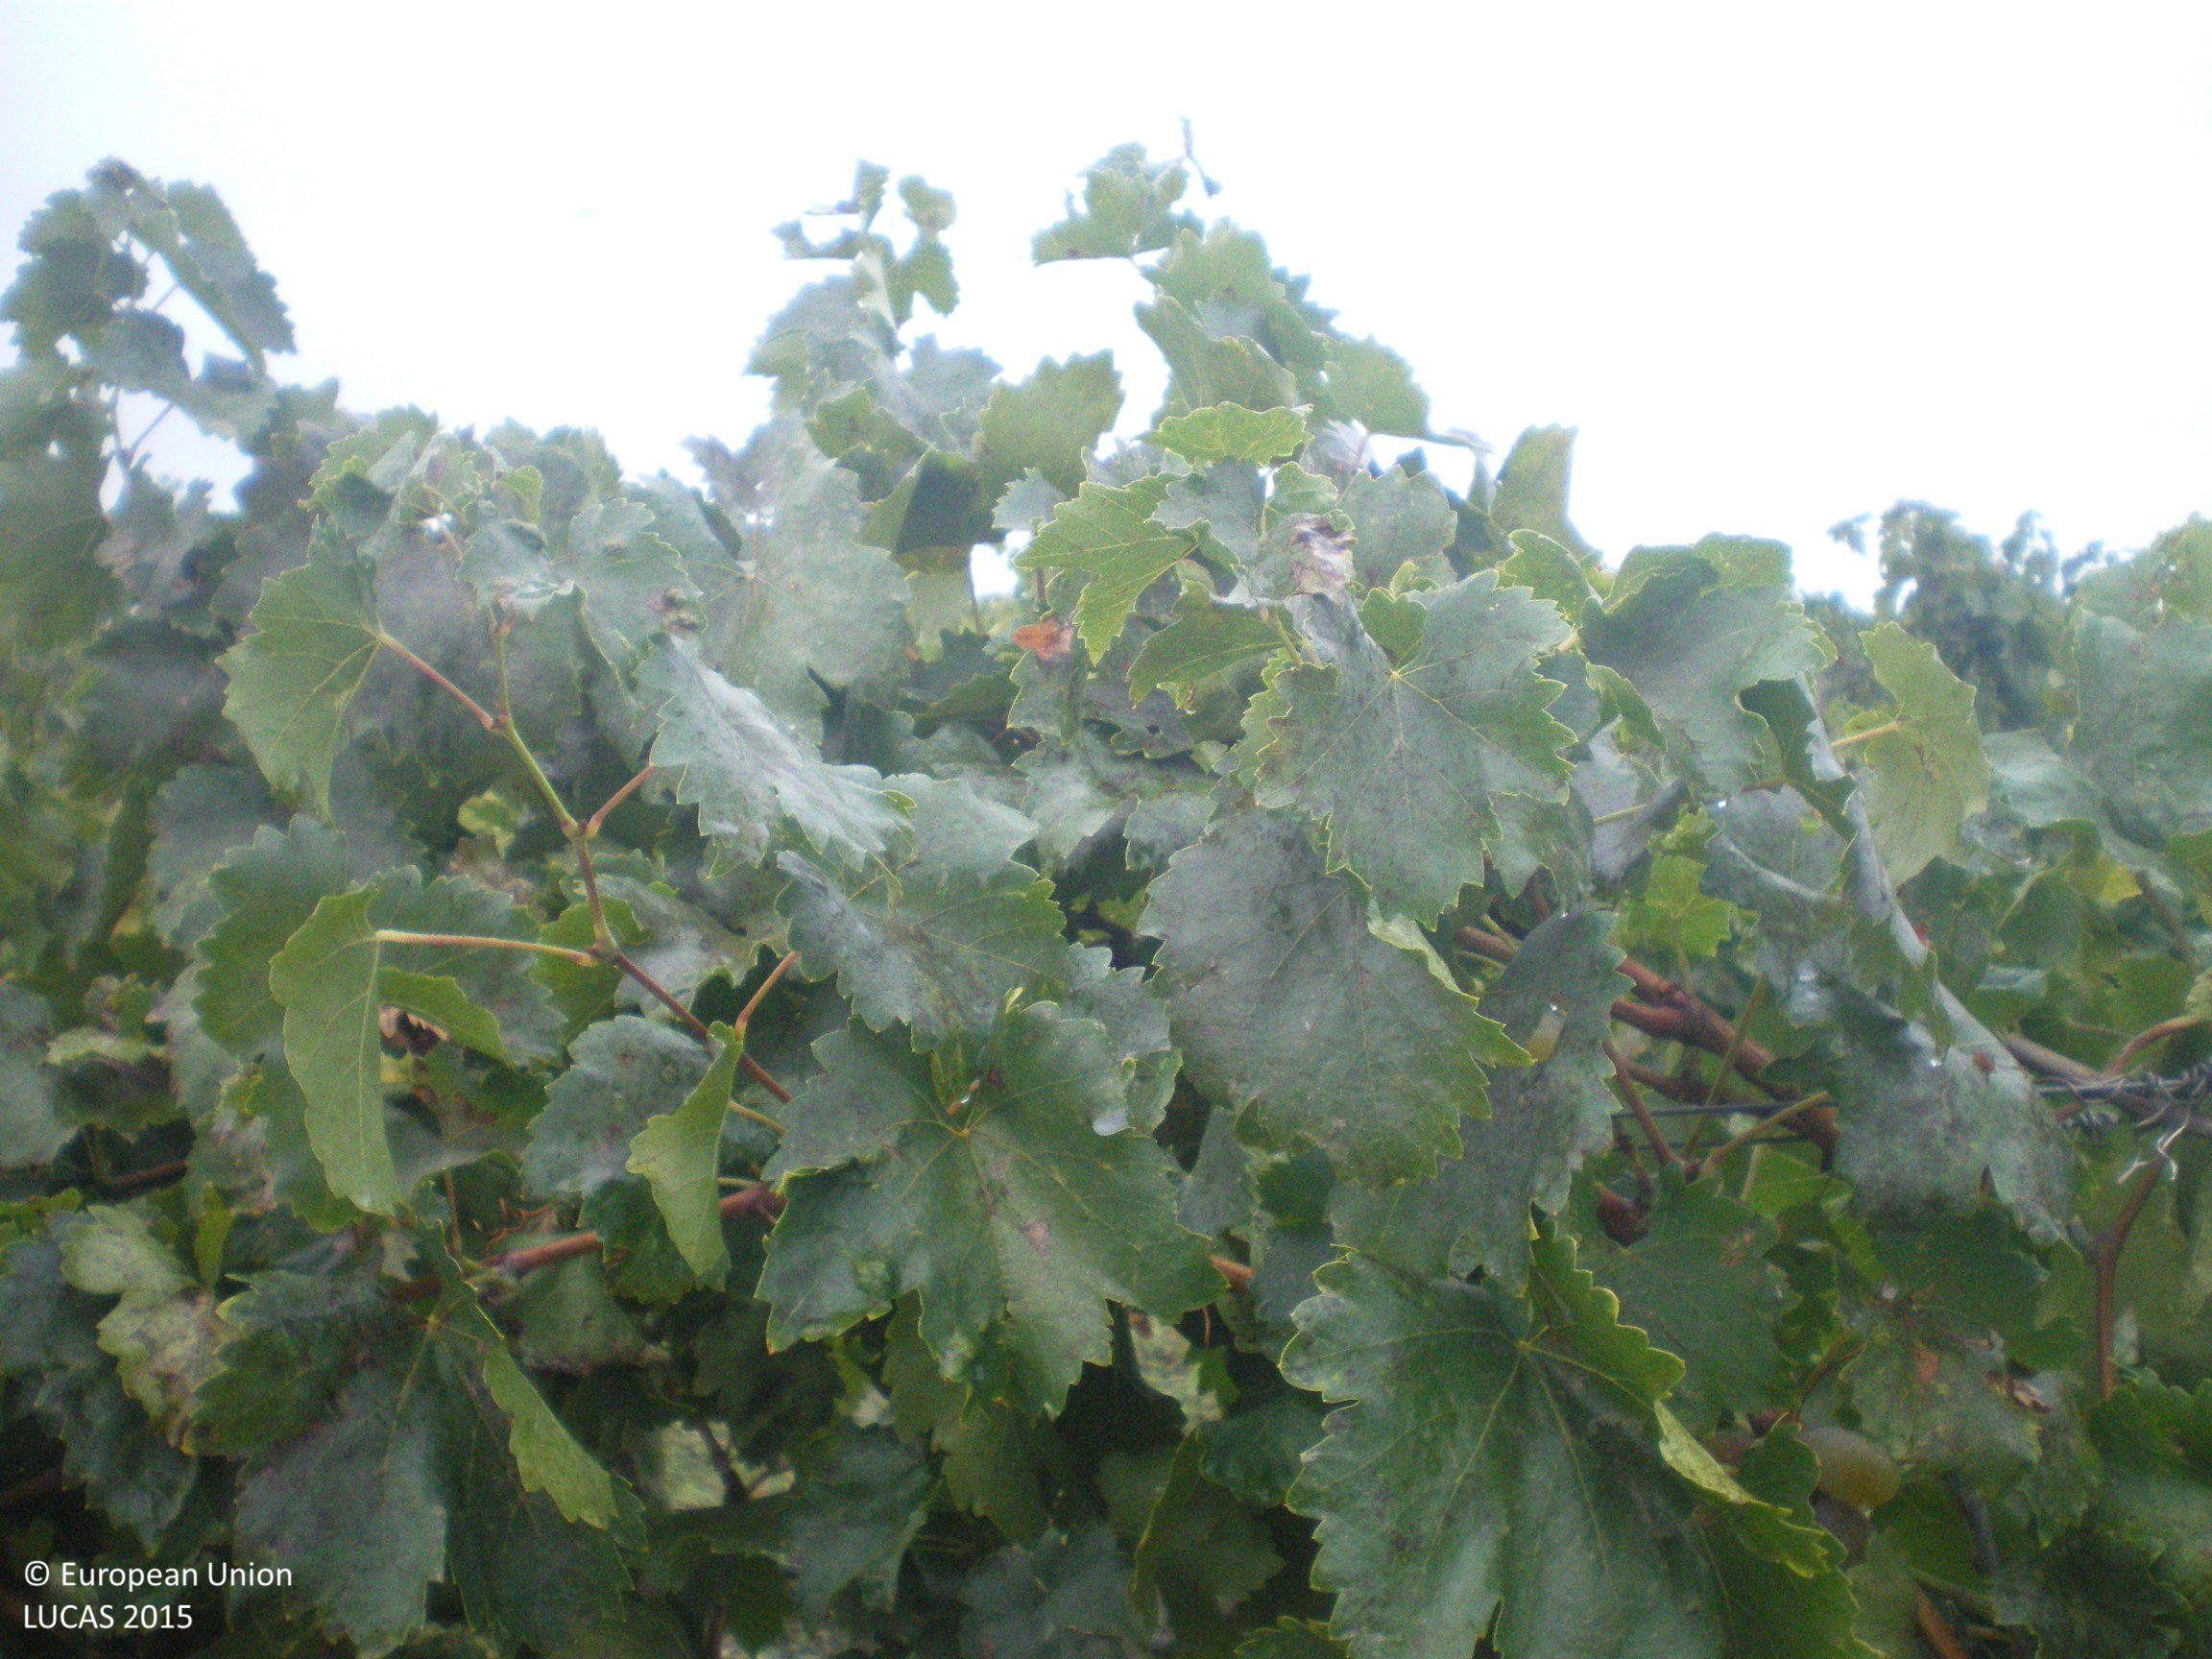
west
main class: Cropland
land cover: Vineyards
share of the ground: 25 - 50 %
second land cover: Other bare soil
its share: > 75 %
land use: Agriculture (excluding fallow land and kitchen gardens)
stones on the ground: < 10 %
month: October
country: BG
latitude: 41.8107
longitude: 26.2432
